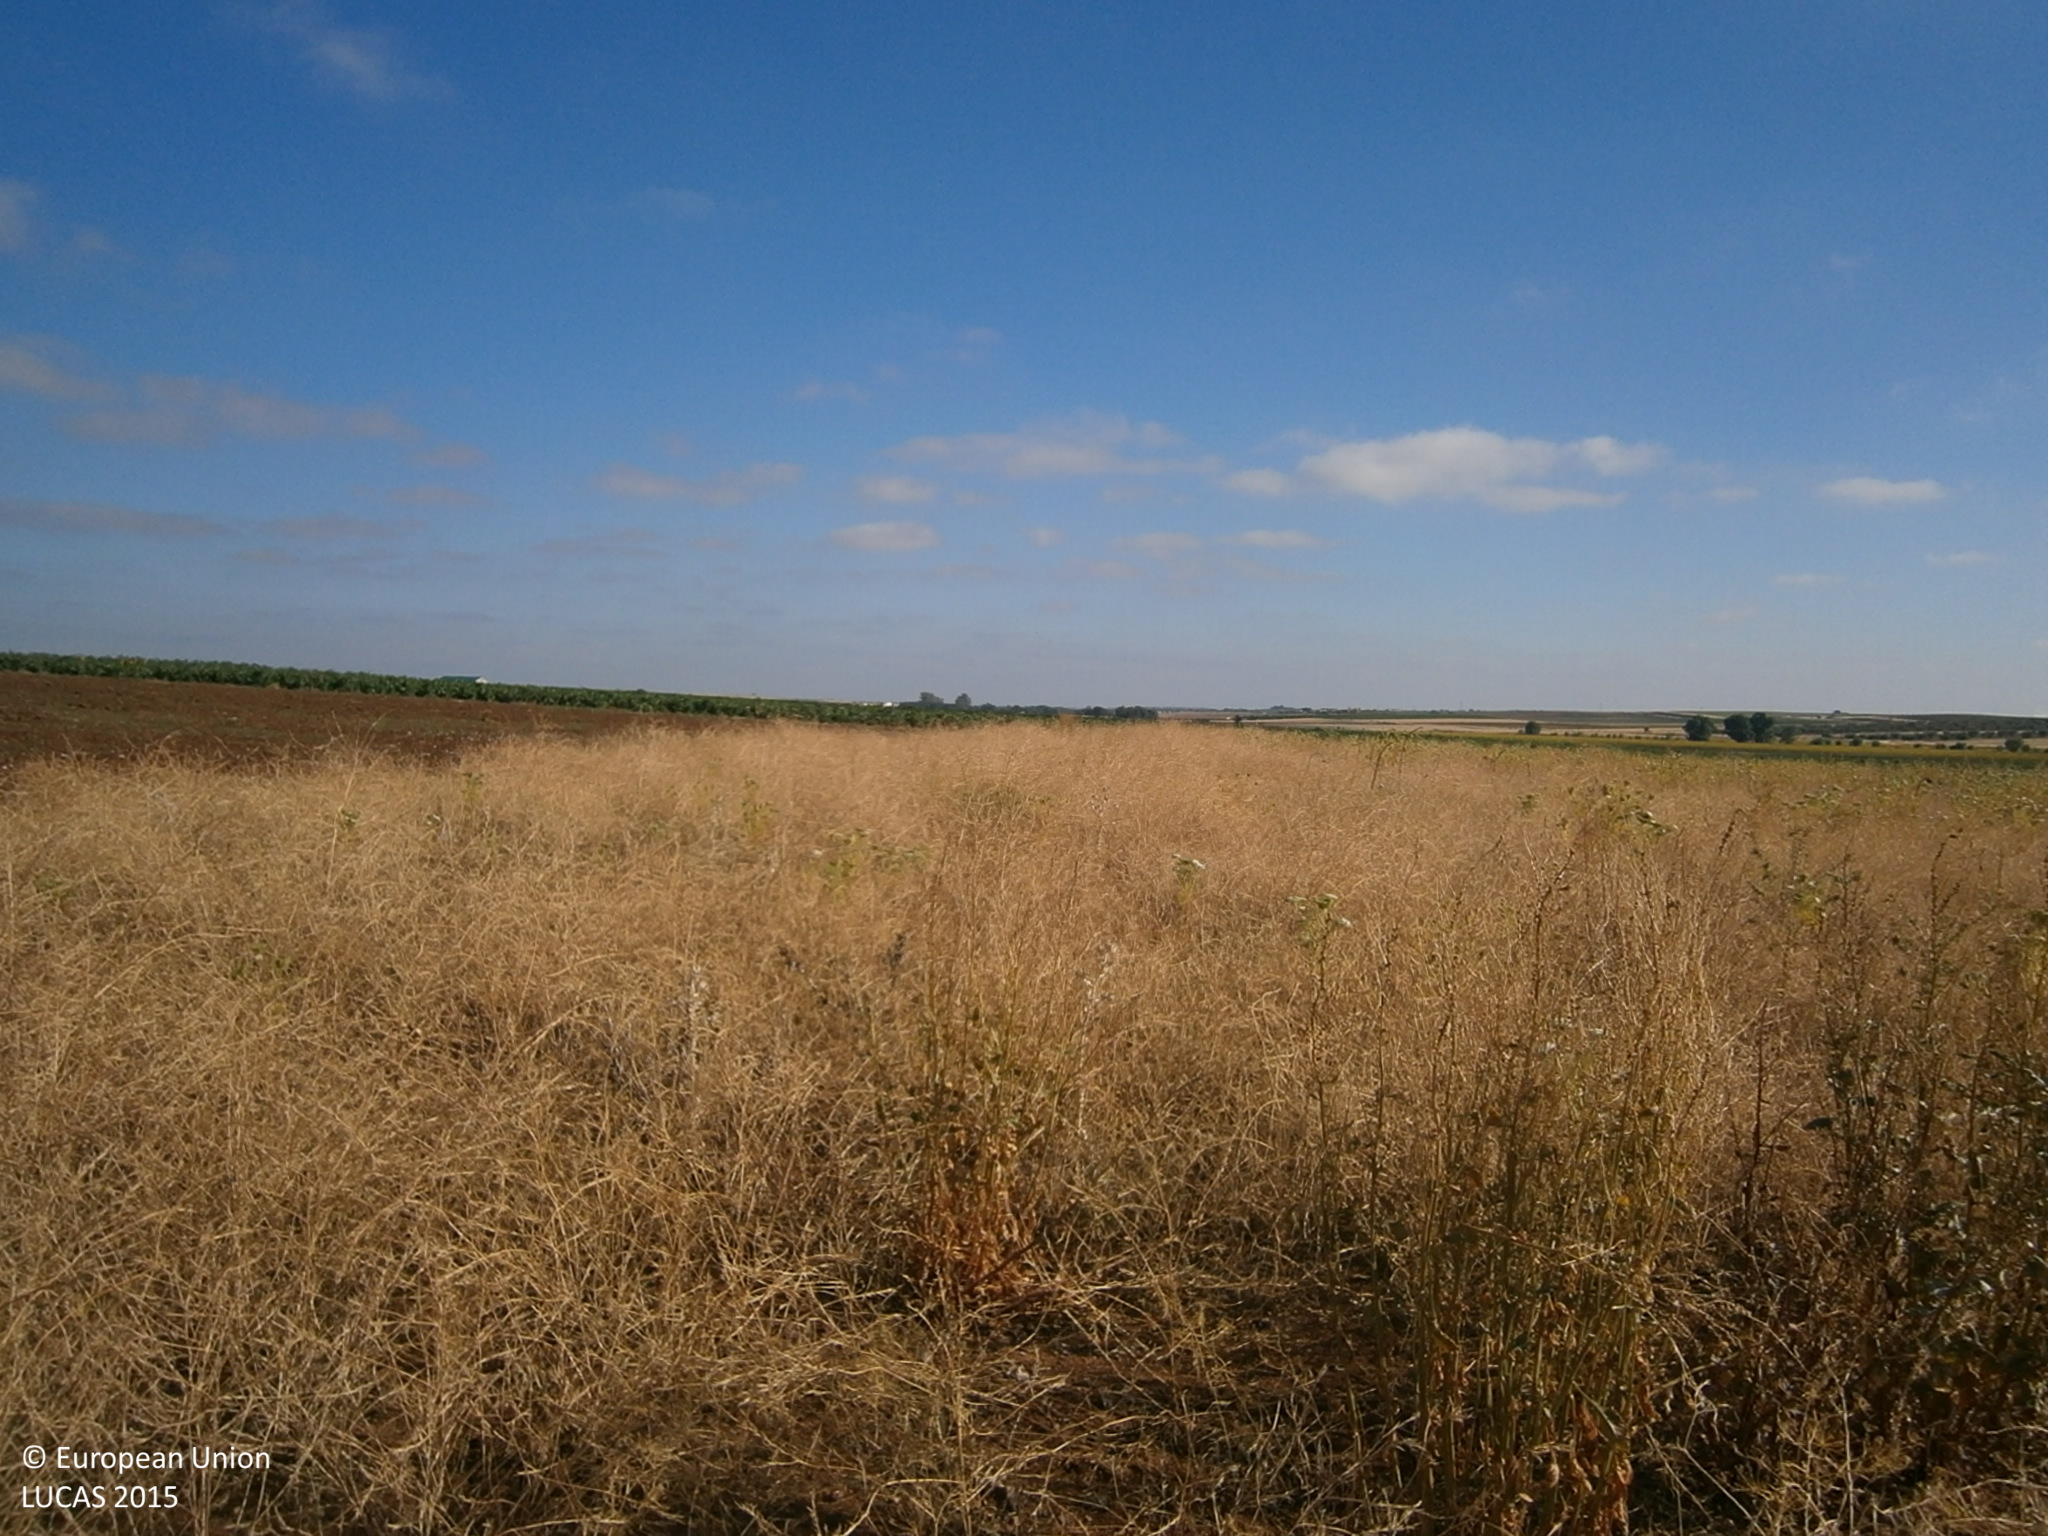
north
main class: Grassland
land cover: Spontaneously vegetated surfaces
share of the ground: > 75 %
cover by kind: herbaceous plants 95 %, unconsolidated bare surface 5 %
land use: Fallow land
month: June
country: ES
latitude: 38.7073
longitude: -6.8417
